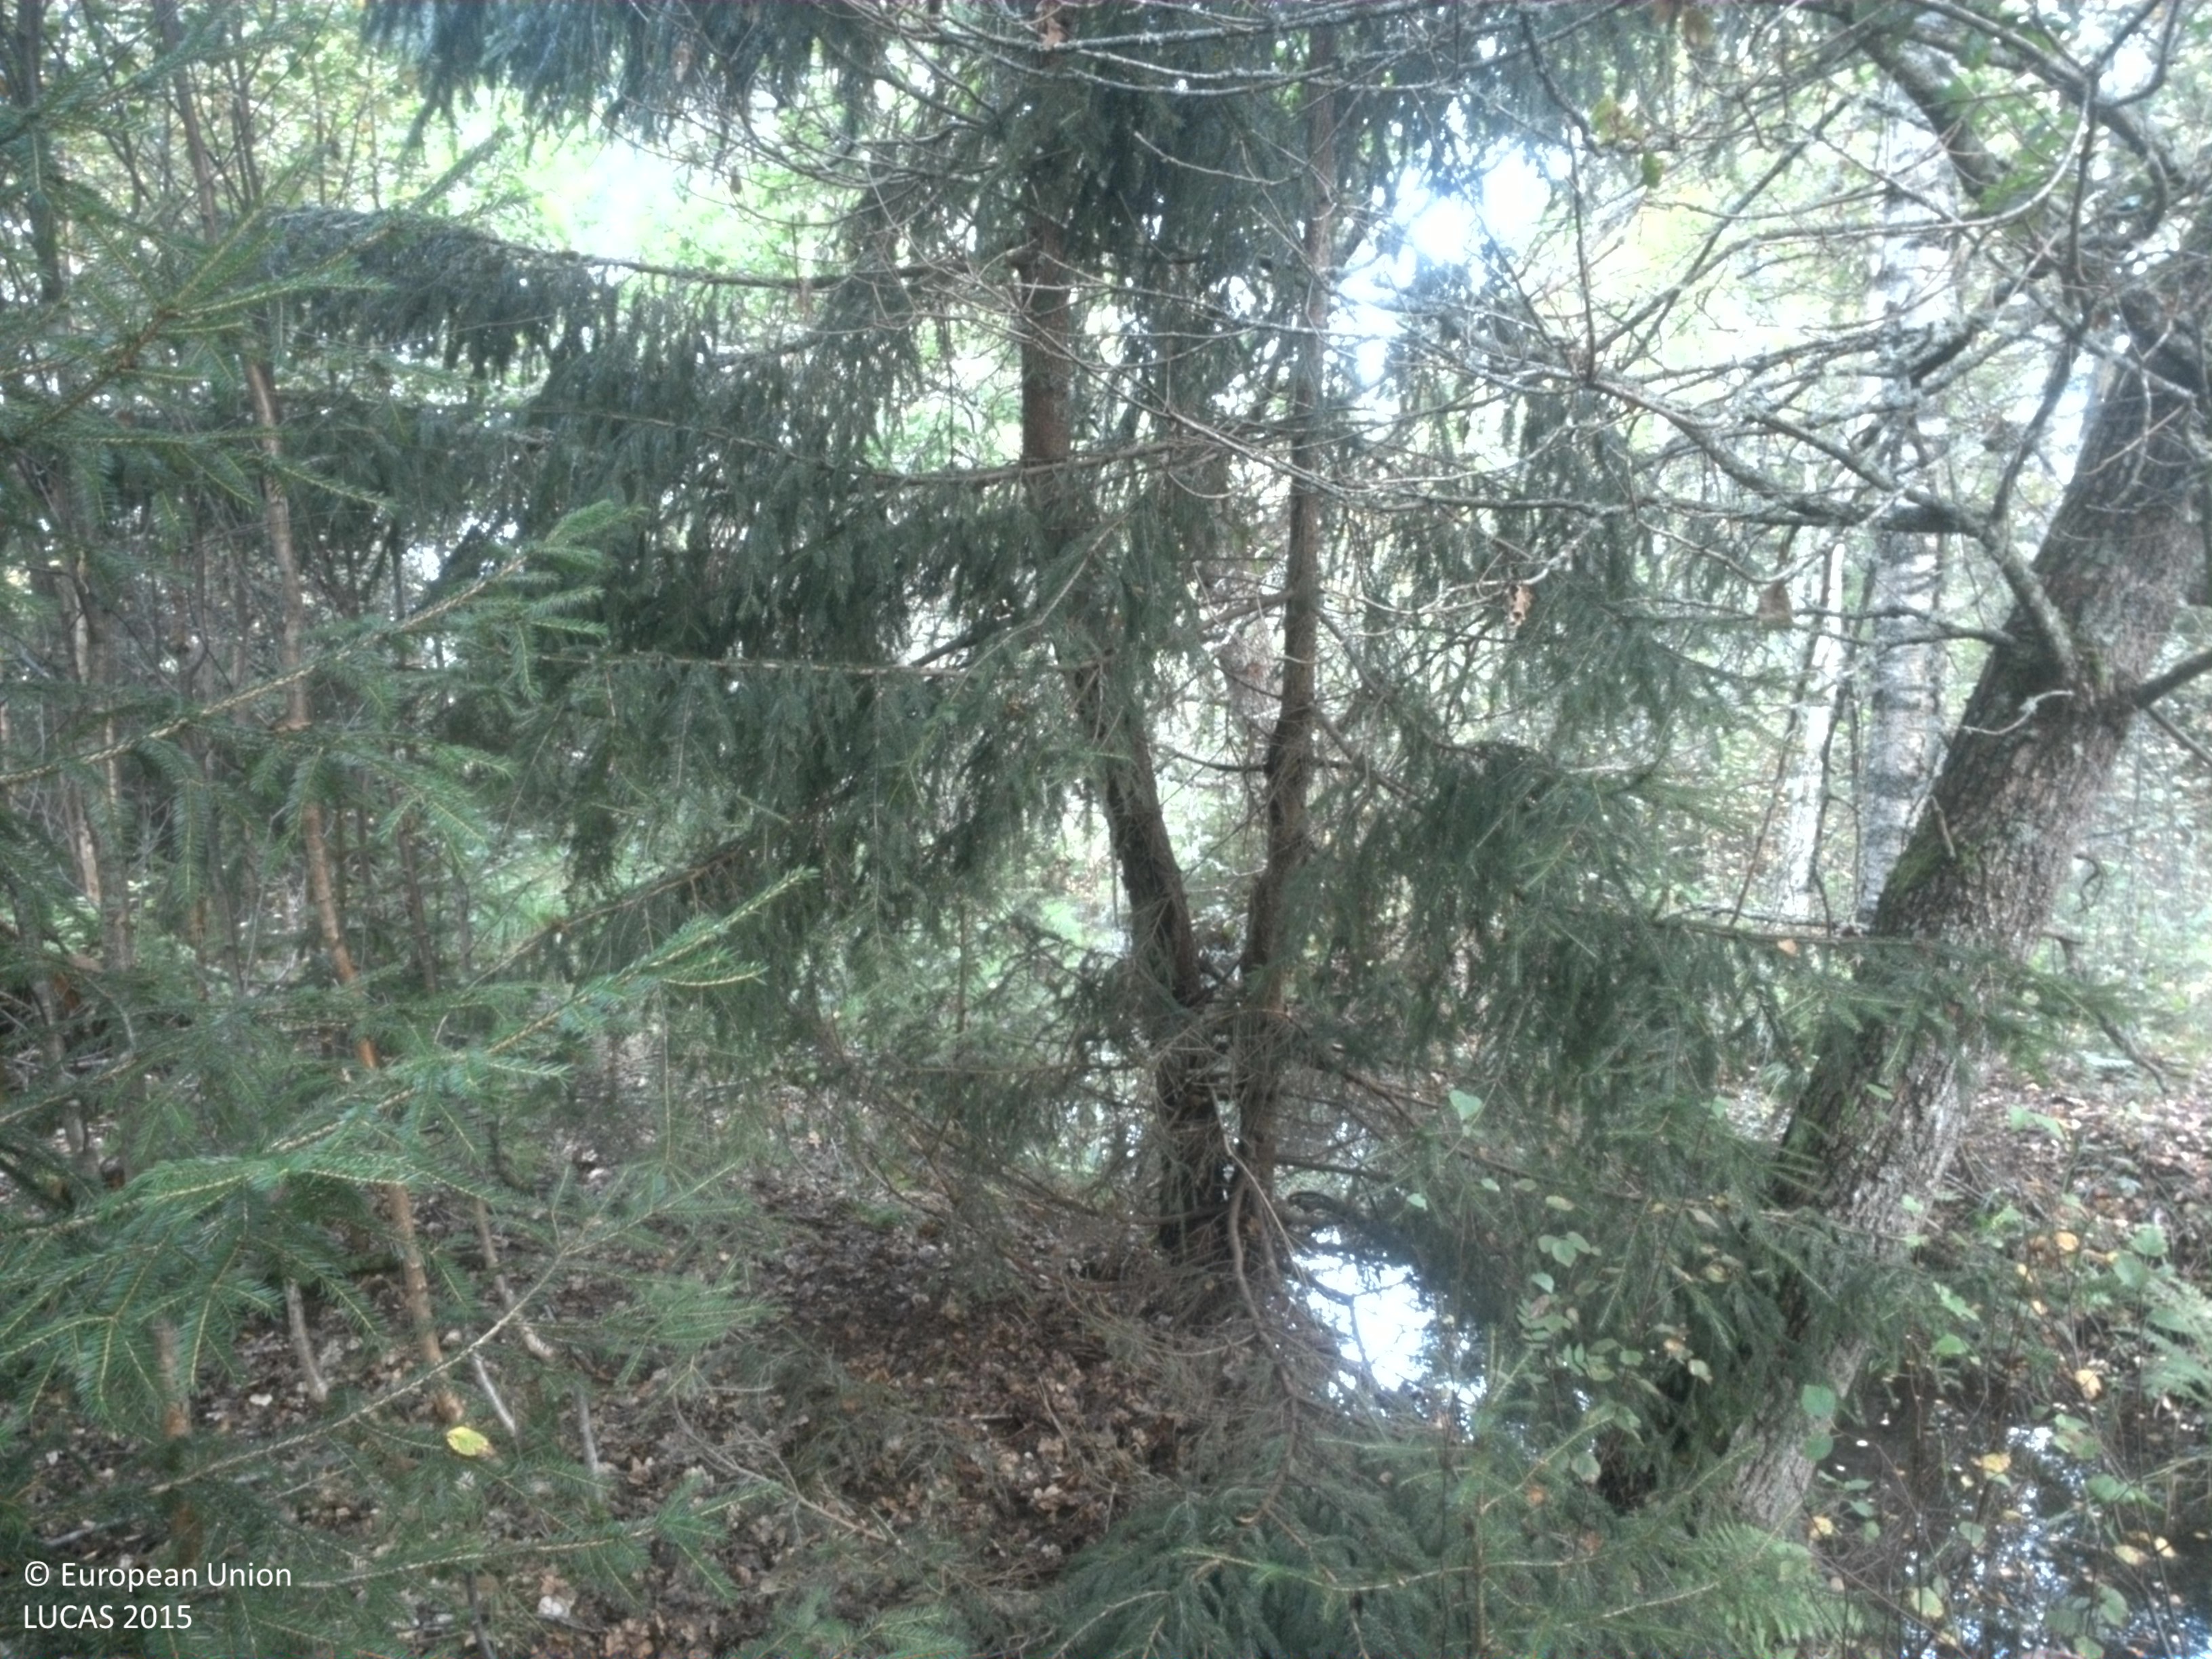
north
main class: Woodland
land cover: Spruce dominated mixed woodland
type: boreal forest
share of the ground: > 75 %
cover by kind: broadleaved forest trees 50 %, coniferous forest trees 25 %, unconsolidated bare surface 10 %, shrubs 5 %, herbaceous plants 5 %
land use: Forestry
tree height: > 5 m
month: September
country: SE
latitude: 59.5569
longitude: 15.7771
